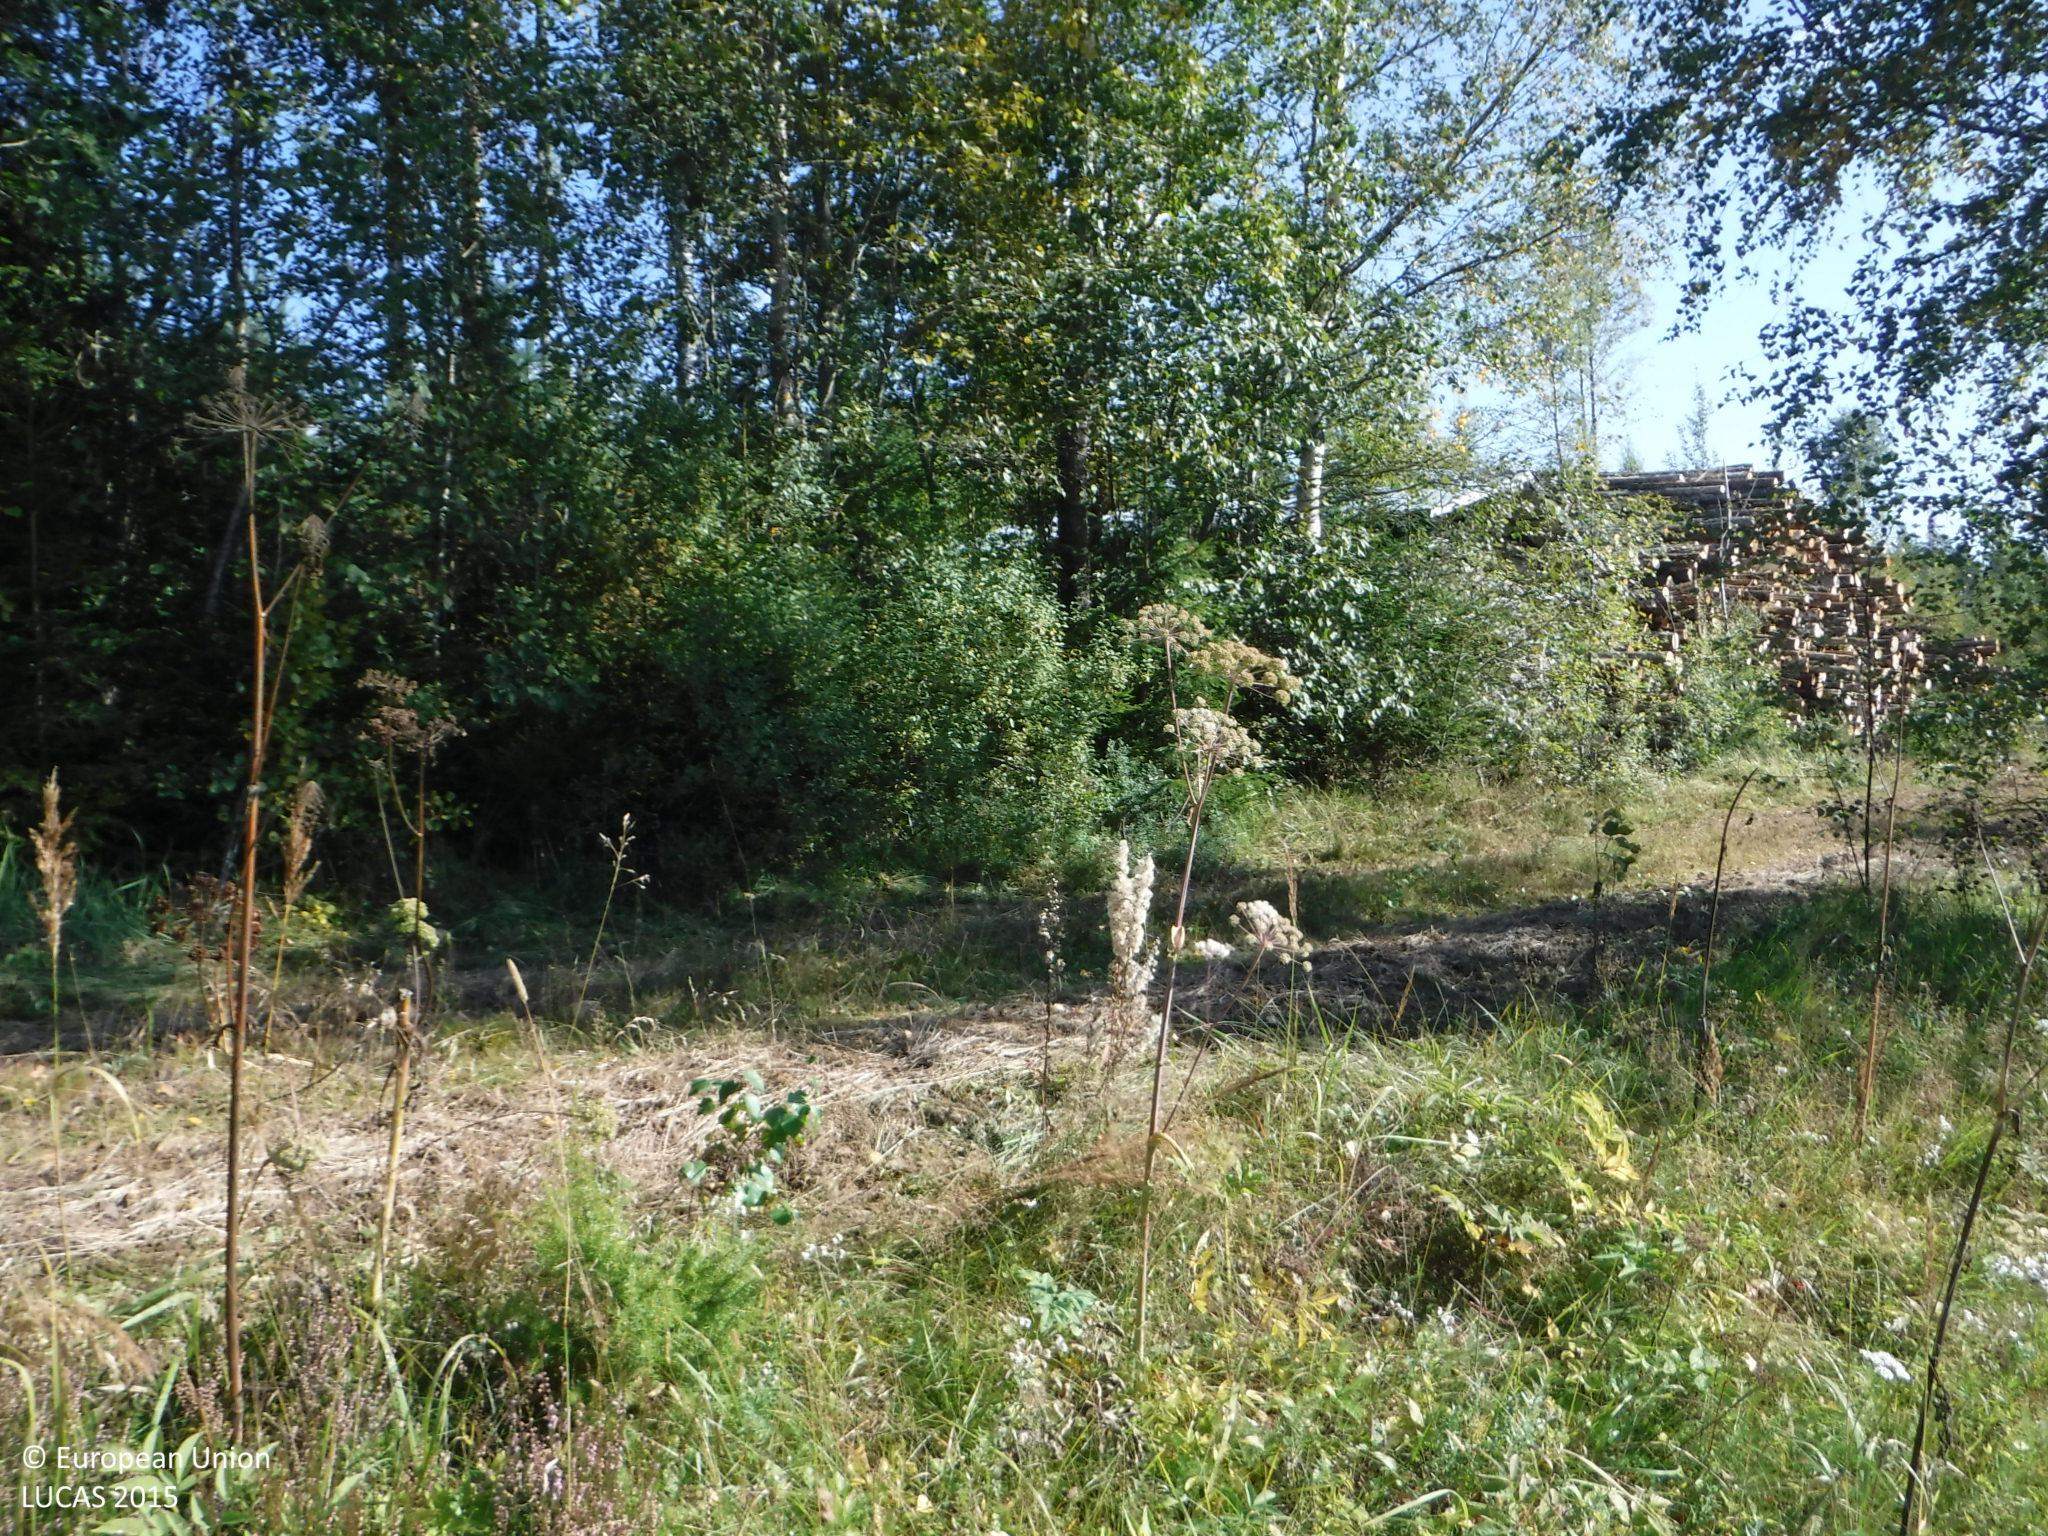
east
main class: Cropland
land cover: Rape and turnip rape
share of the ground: 50 - 75 %
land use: Agriculture (excluding fallow land and kitchen gardens)
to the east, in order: Rape and turnip rape; Spontaneously vegetated surfaces; Artificial constructions in urban areas; Pine dominated coniferous woodland; Tracks; Electric lines; Other mixed woodland; Tracks; Ditches and canals; Groves; Pine dominated coniferous woodland; Other coniferous woodland
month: September
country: FI
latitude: 61.8040
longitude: 22.8343
